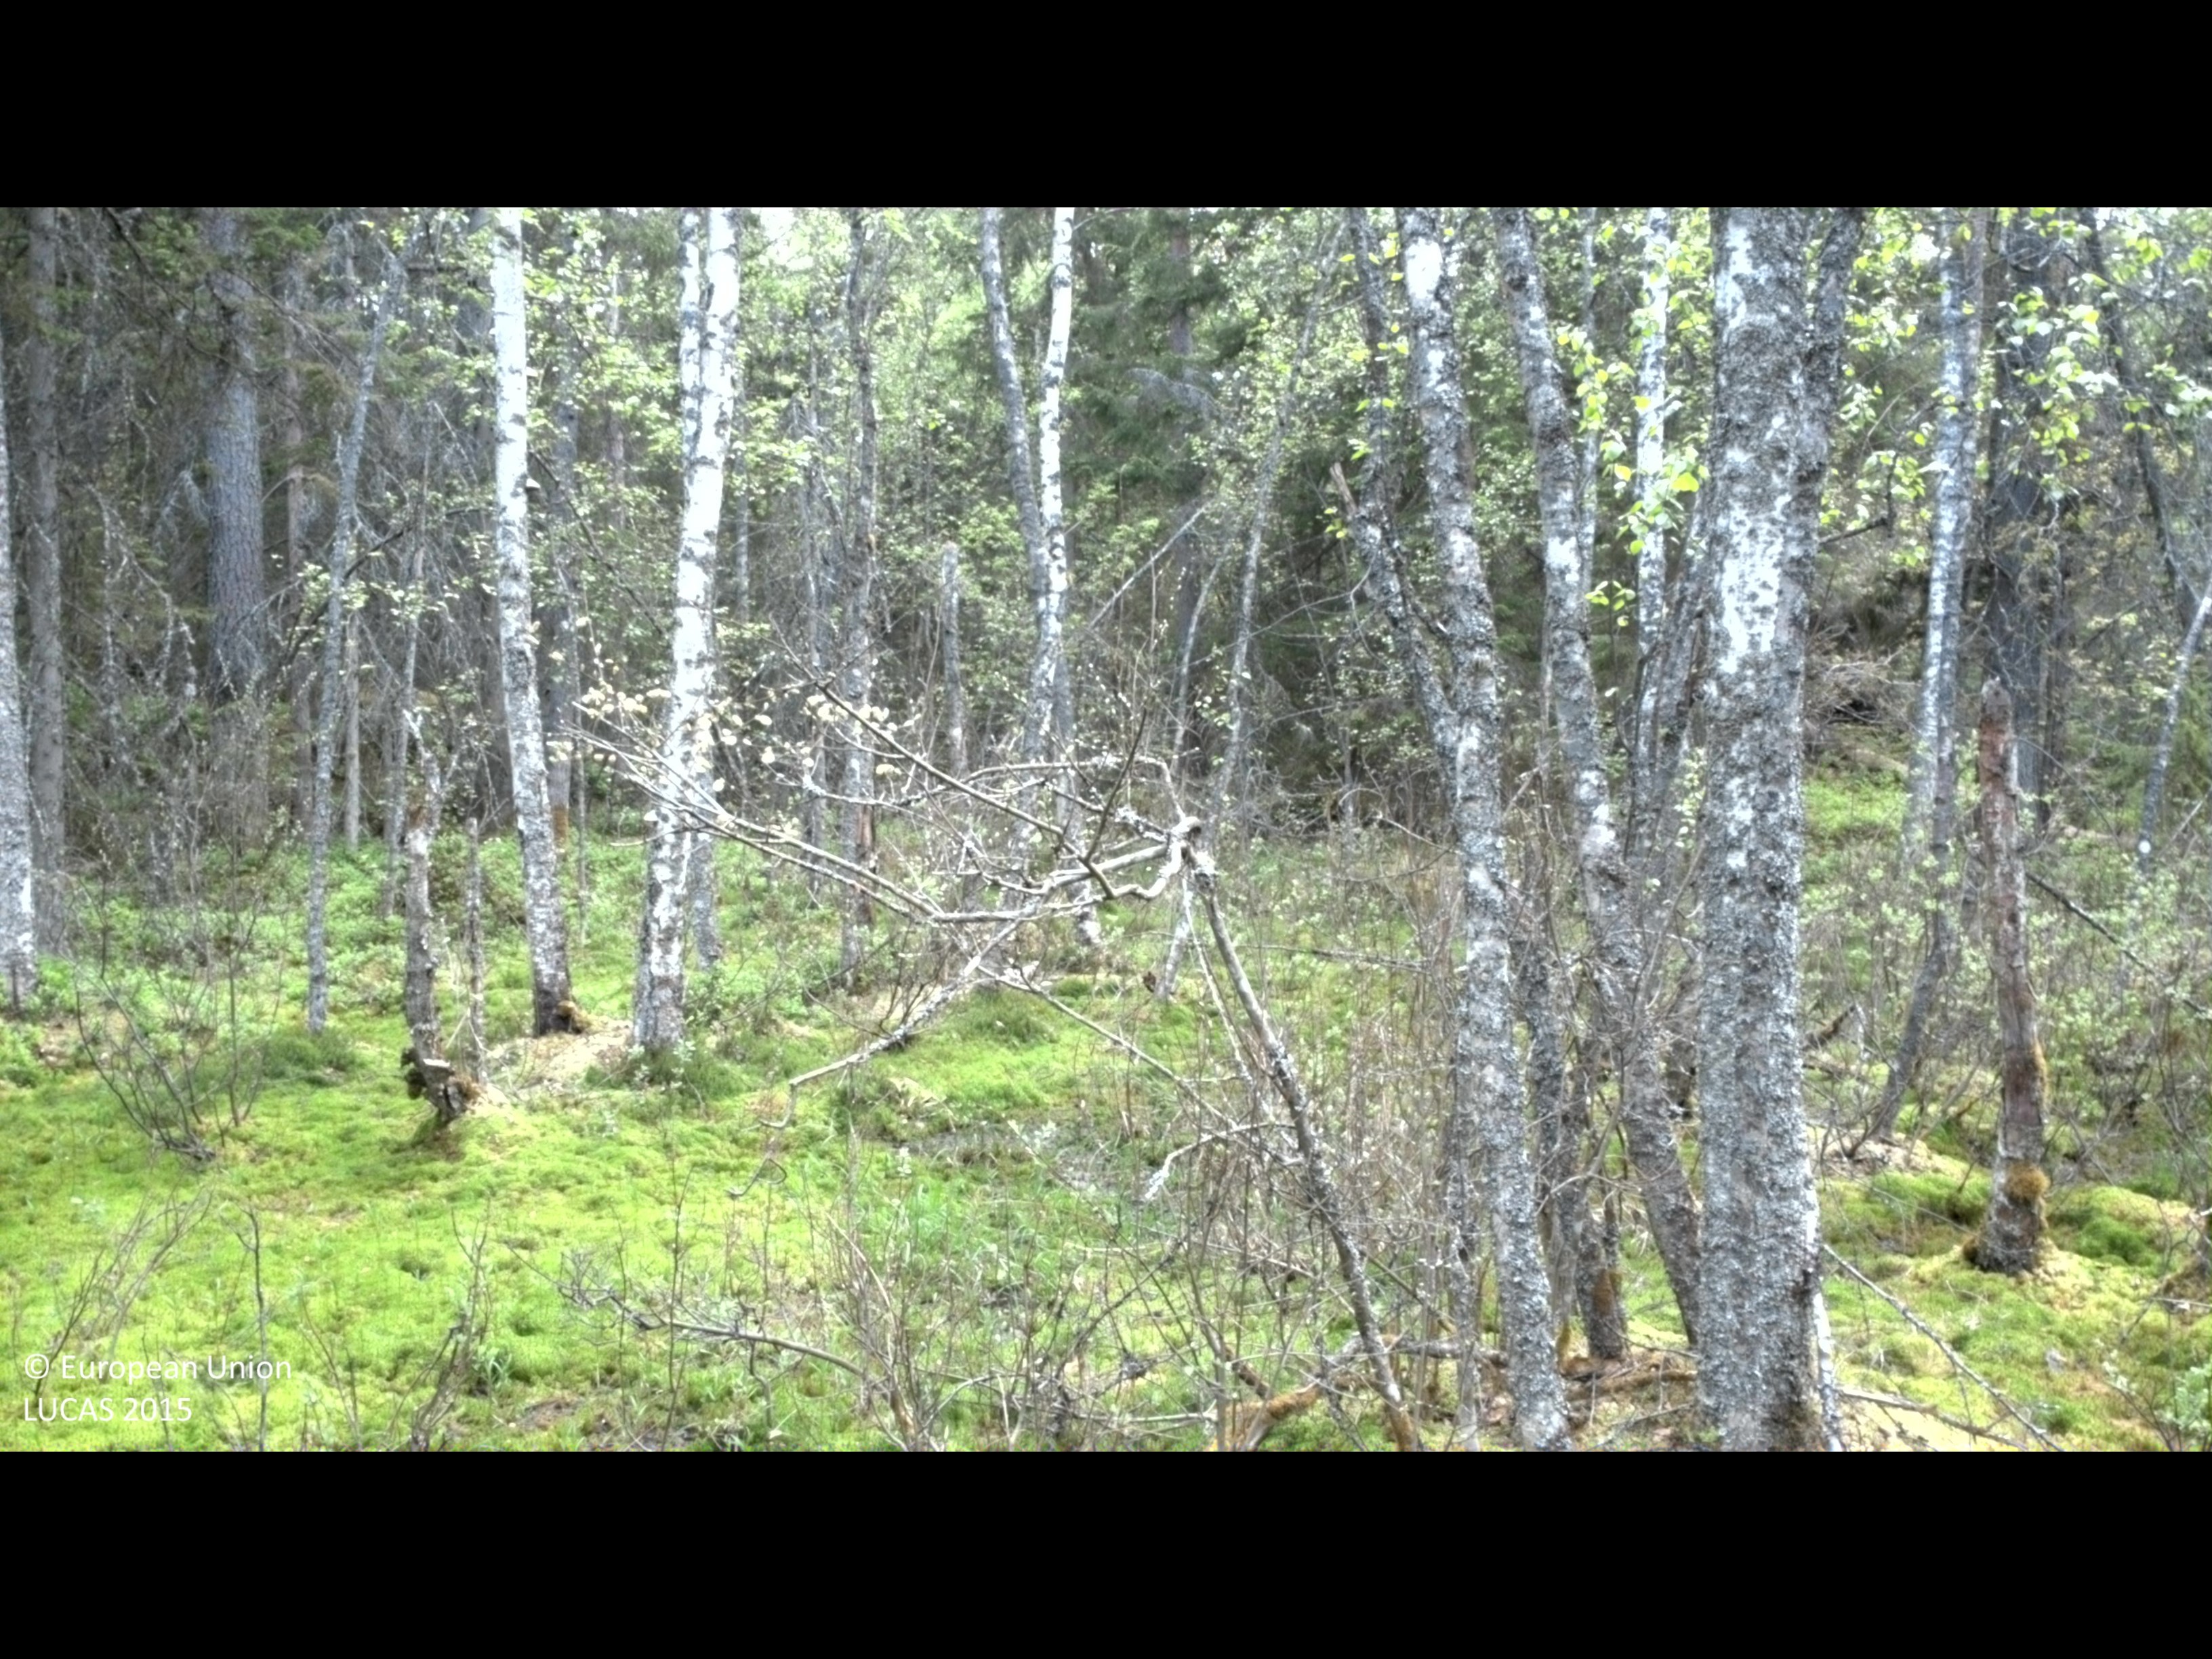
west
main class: Woodland
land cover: Pine dominated mixed woodland
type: boreal forest
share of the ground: > 75 %
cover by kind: coniferous forest trees 60 %, broadleaved forest trees 20 %, shrubs 10 %, lichens and mosses 10 %
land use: Forestry
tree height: > 5 m
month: May
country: SE
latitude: 57.3548
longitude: 16.1984
